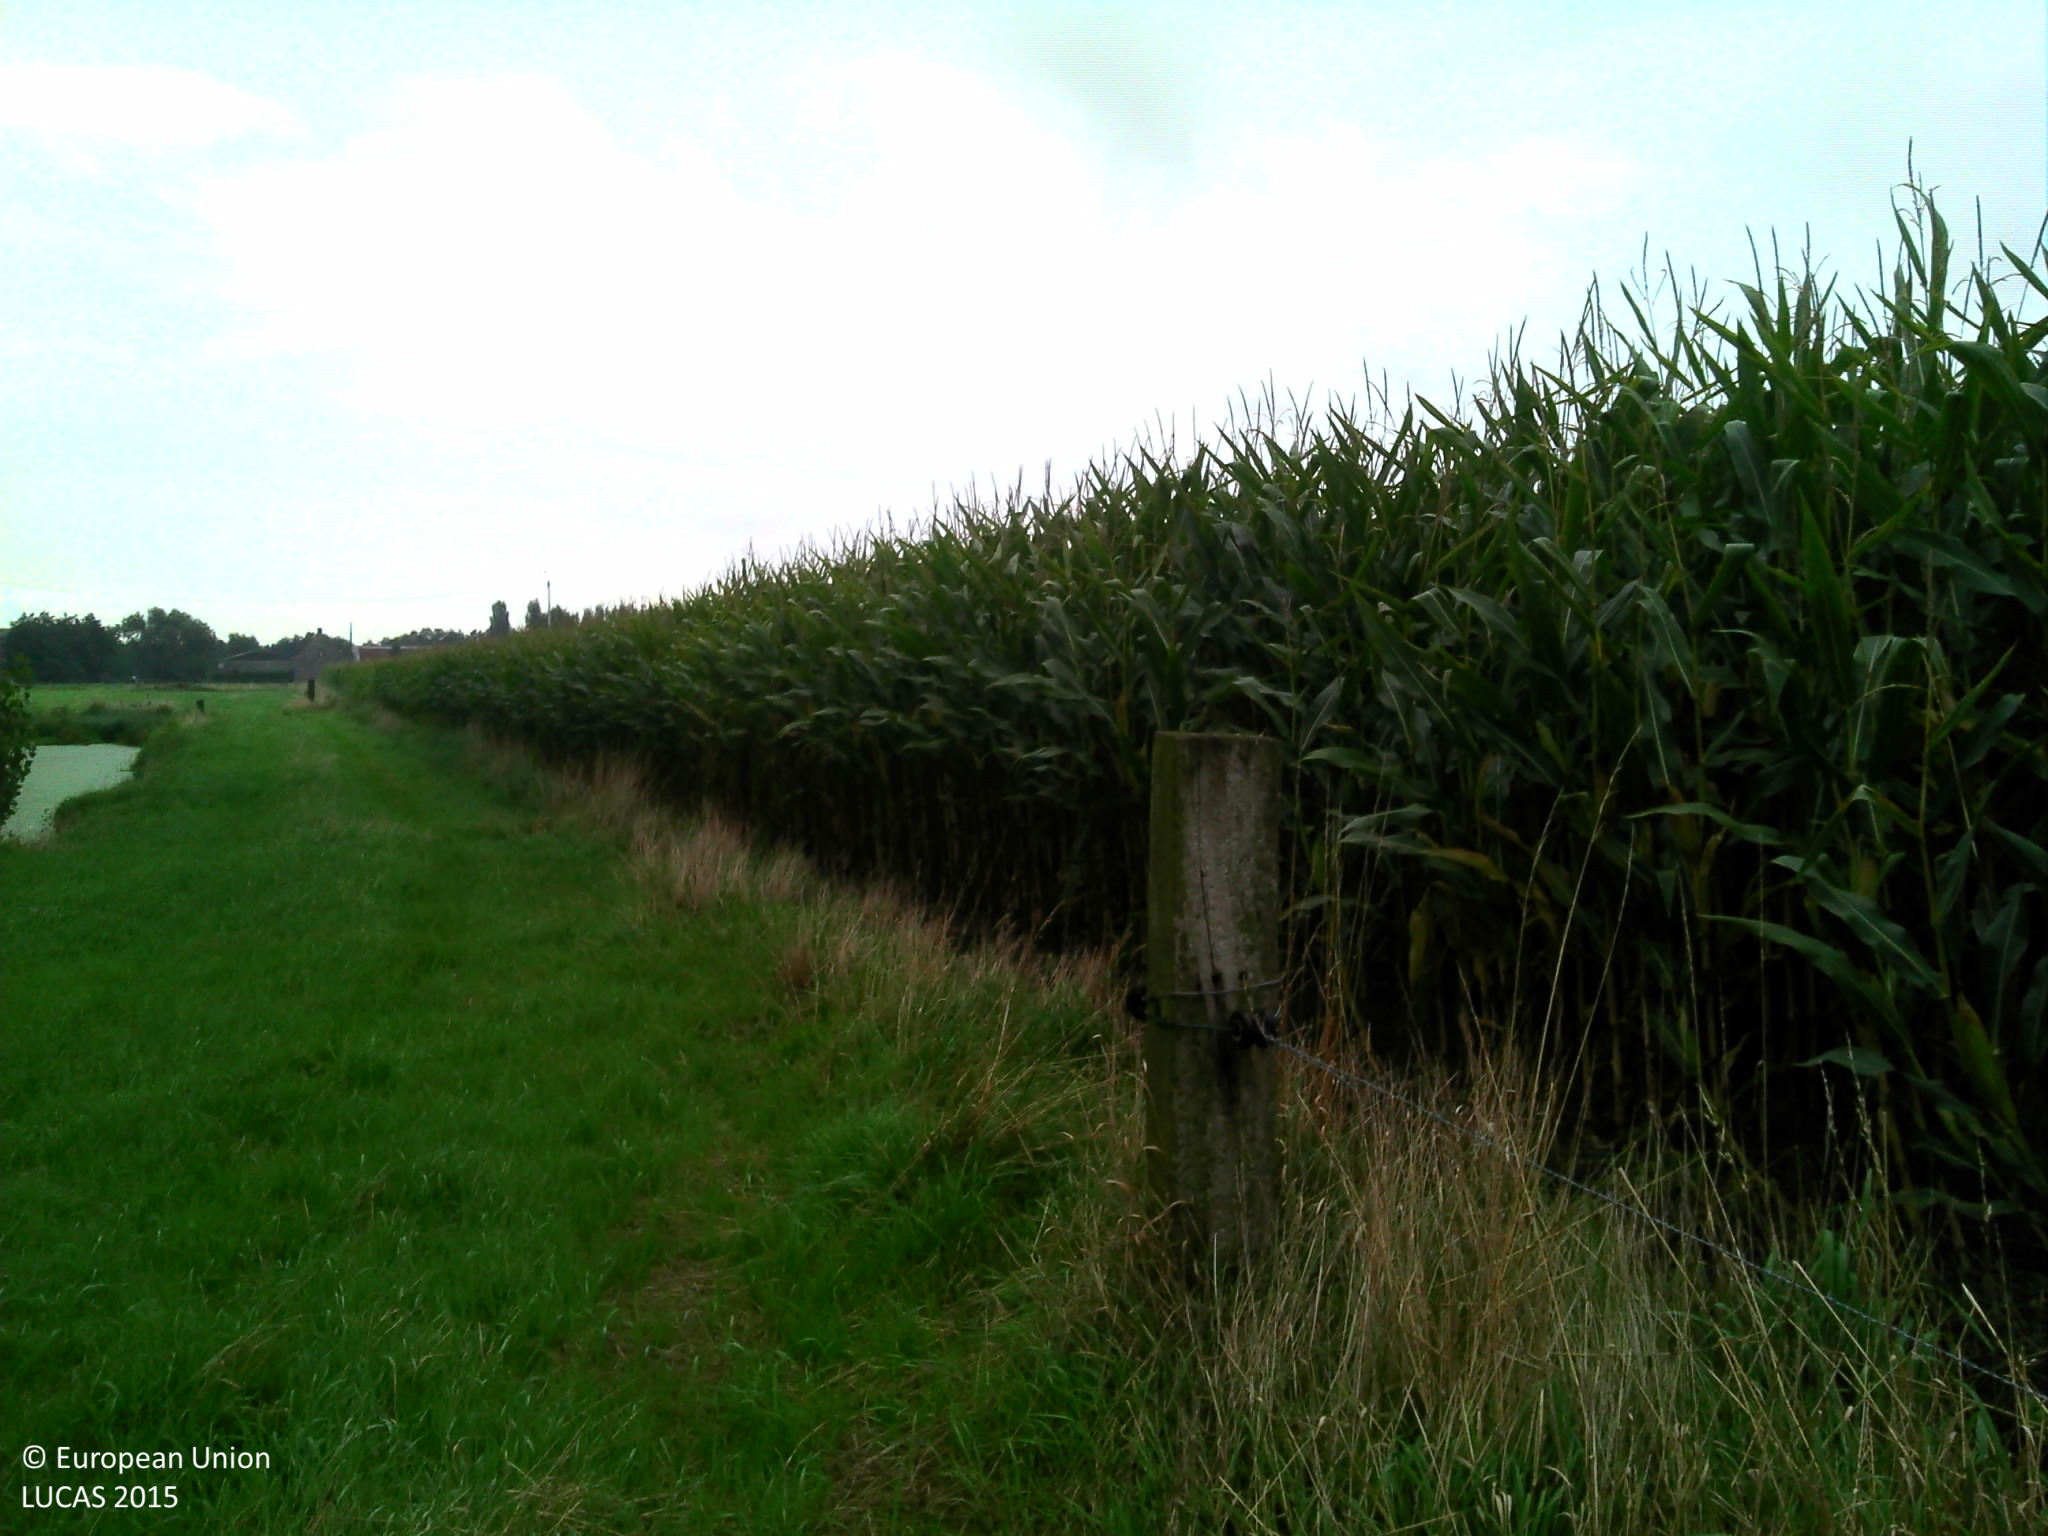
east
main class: Grassland
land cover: Grassland without tree/shrub cover
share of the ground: > 75 %
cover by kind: herbaceous plants 100 %
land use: Agriculture (excluding fallow land and kitchen gardens)
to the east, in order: Grassland without tree/shrub cover; Maize; Electric lines; Ditches and canals; Grass margins; Paved roads, cycling and walking lanes; Grass margins; Ditches and canals; Fences; Grassland without tree/shrub cover
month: September
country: BE
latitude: 50.9866
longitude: 3.4246
